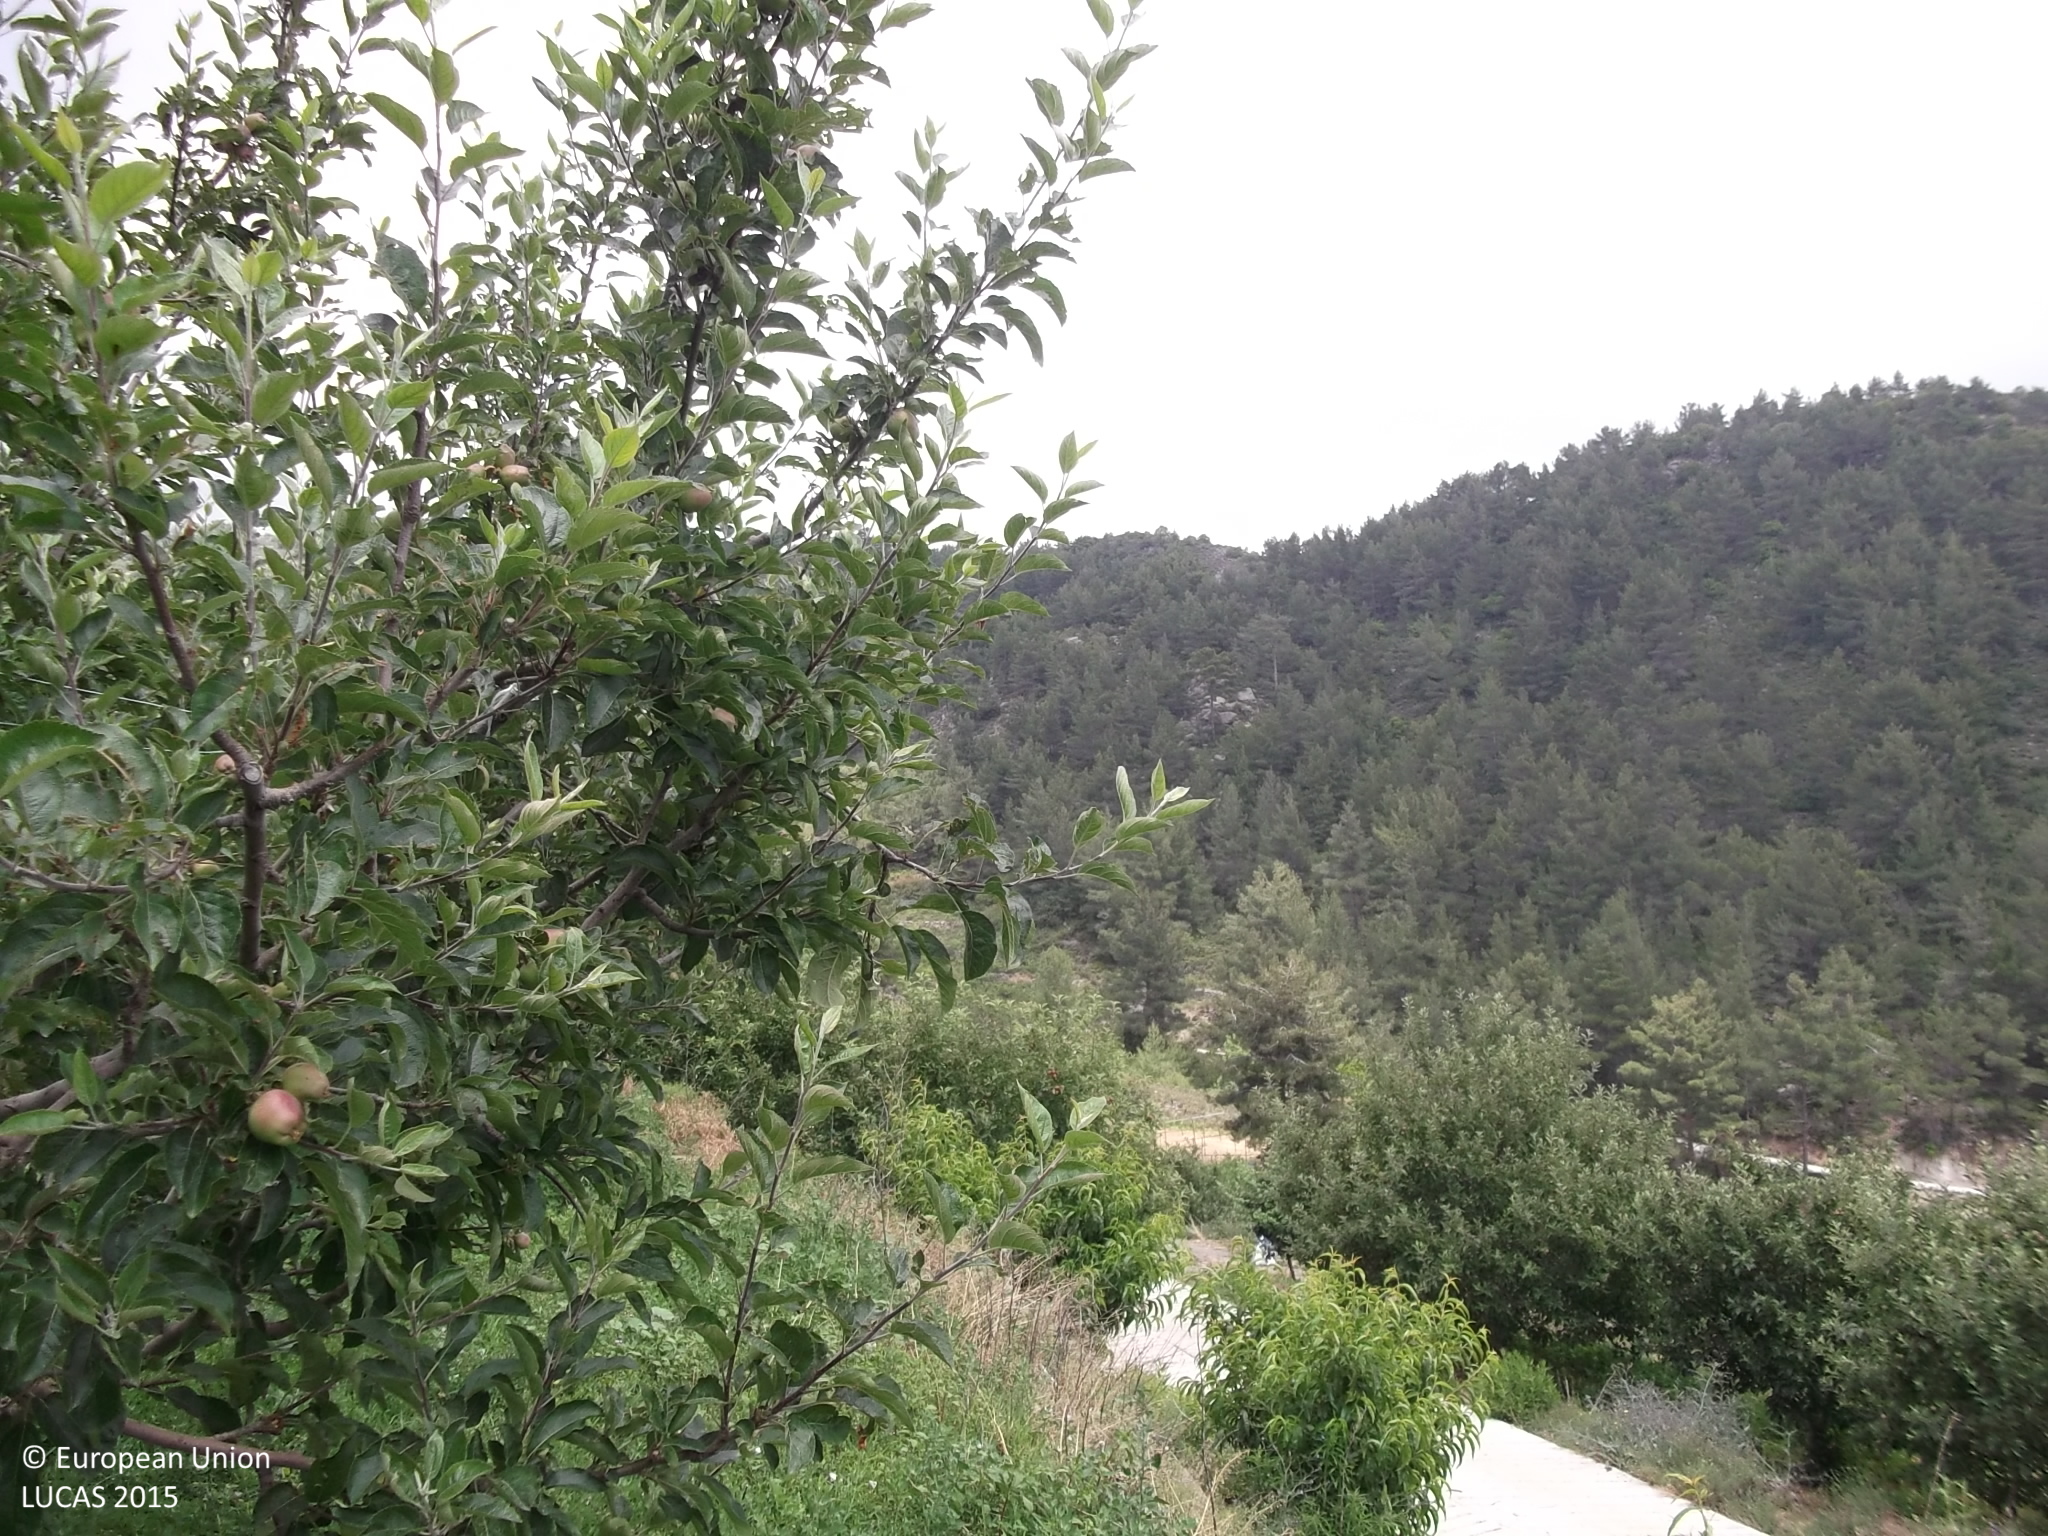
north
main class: Cropland
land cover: Apple fruit
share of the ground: 50 - 75 %
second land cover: Grassland without tree/shrub cover
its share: > 75 %
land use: Agriculture (excluding fallow land and kitchen gardens)
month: June
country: CY
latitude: 34.9144
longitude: 32.9690
